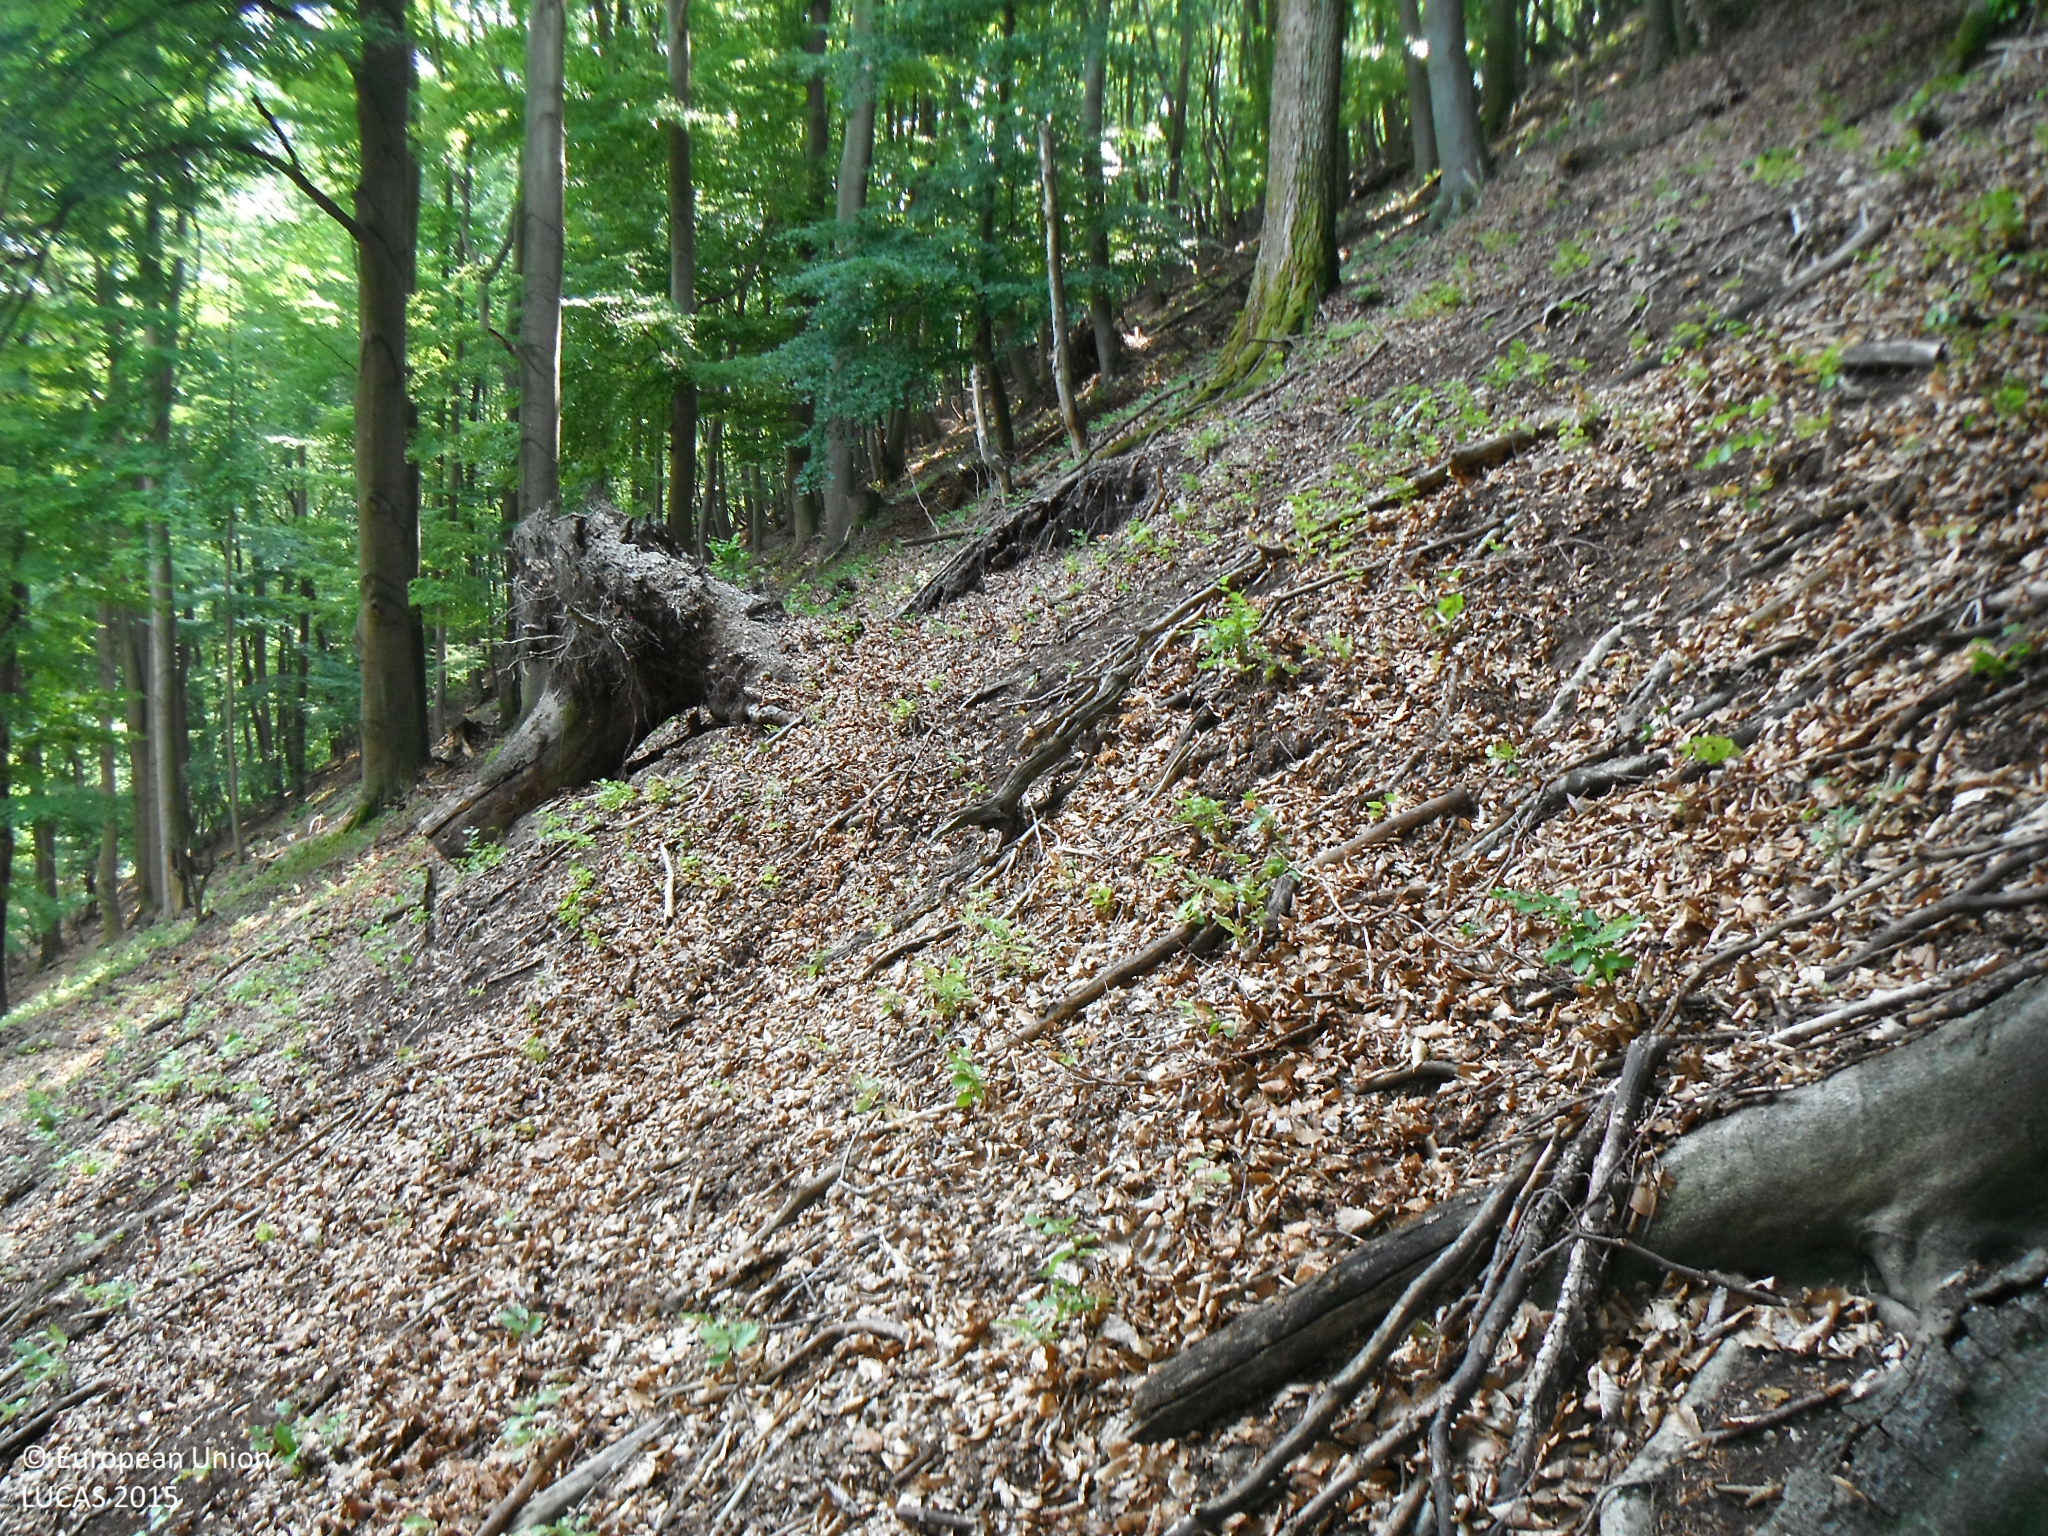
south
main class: Woodland
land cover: Broadleaved woodland
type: mountainous beech forest
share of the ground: > 75 %
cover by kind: broadleaved forest trees 60 %, unconsolidated bare surface 30 %, herbaceous plants 10 %
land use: Forestry
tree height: > 5 m
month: August
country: SK
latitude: 48.9725
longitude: 18.3638
